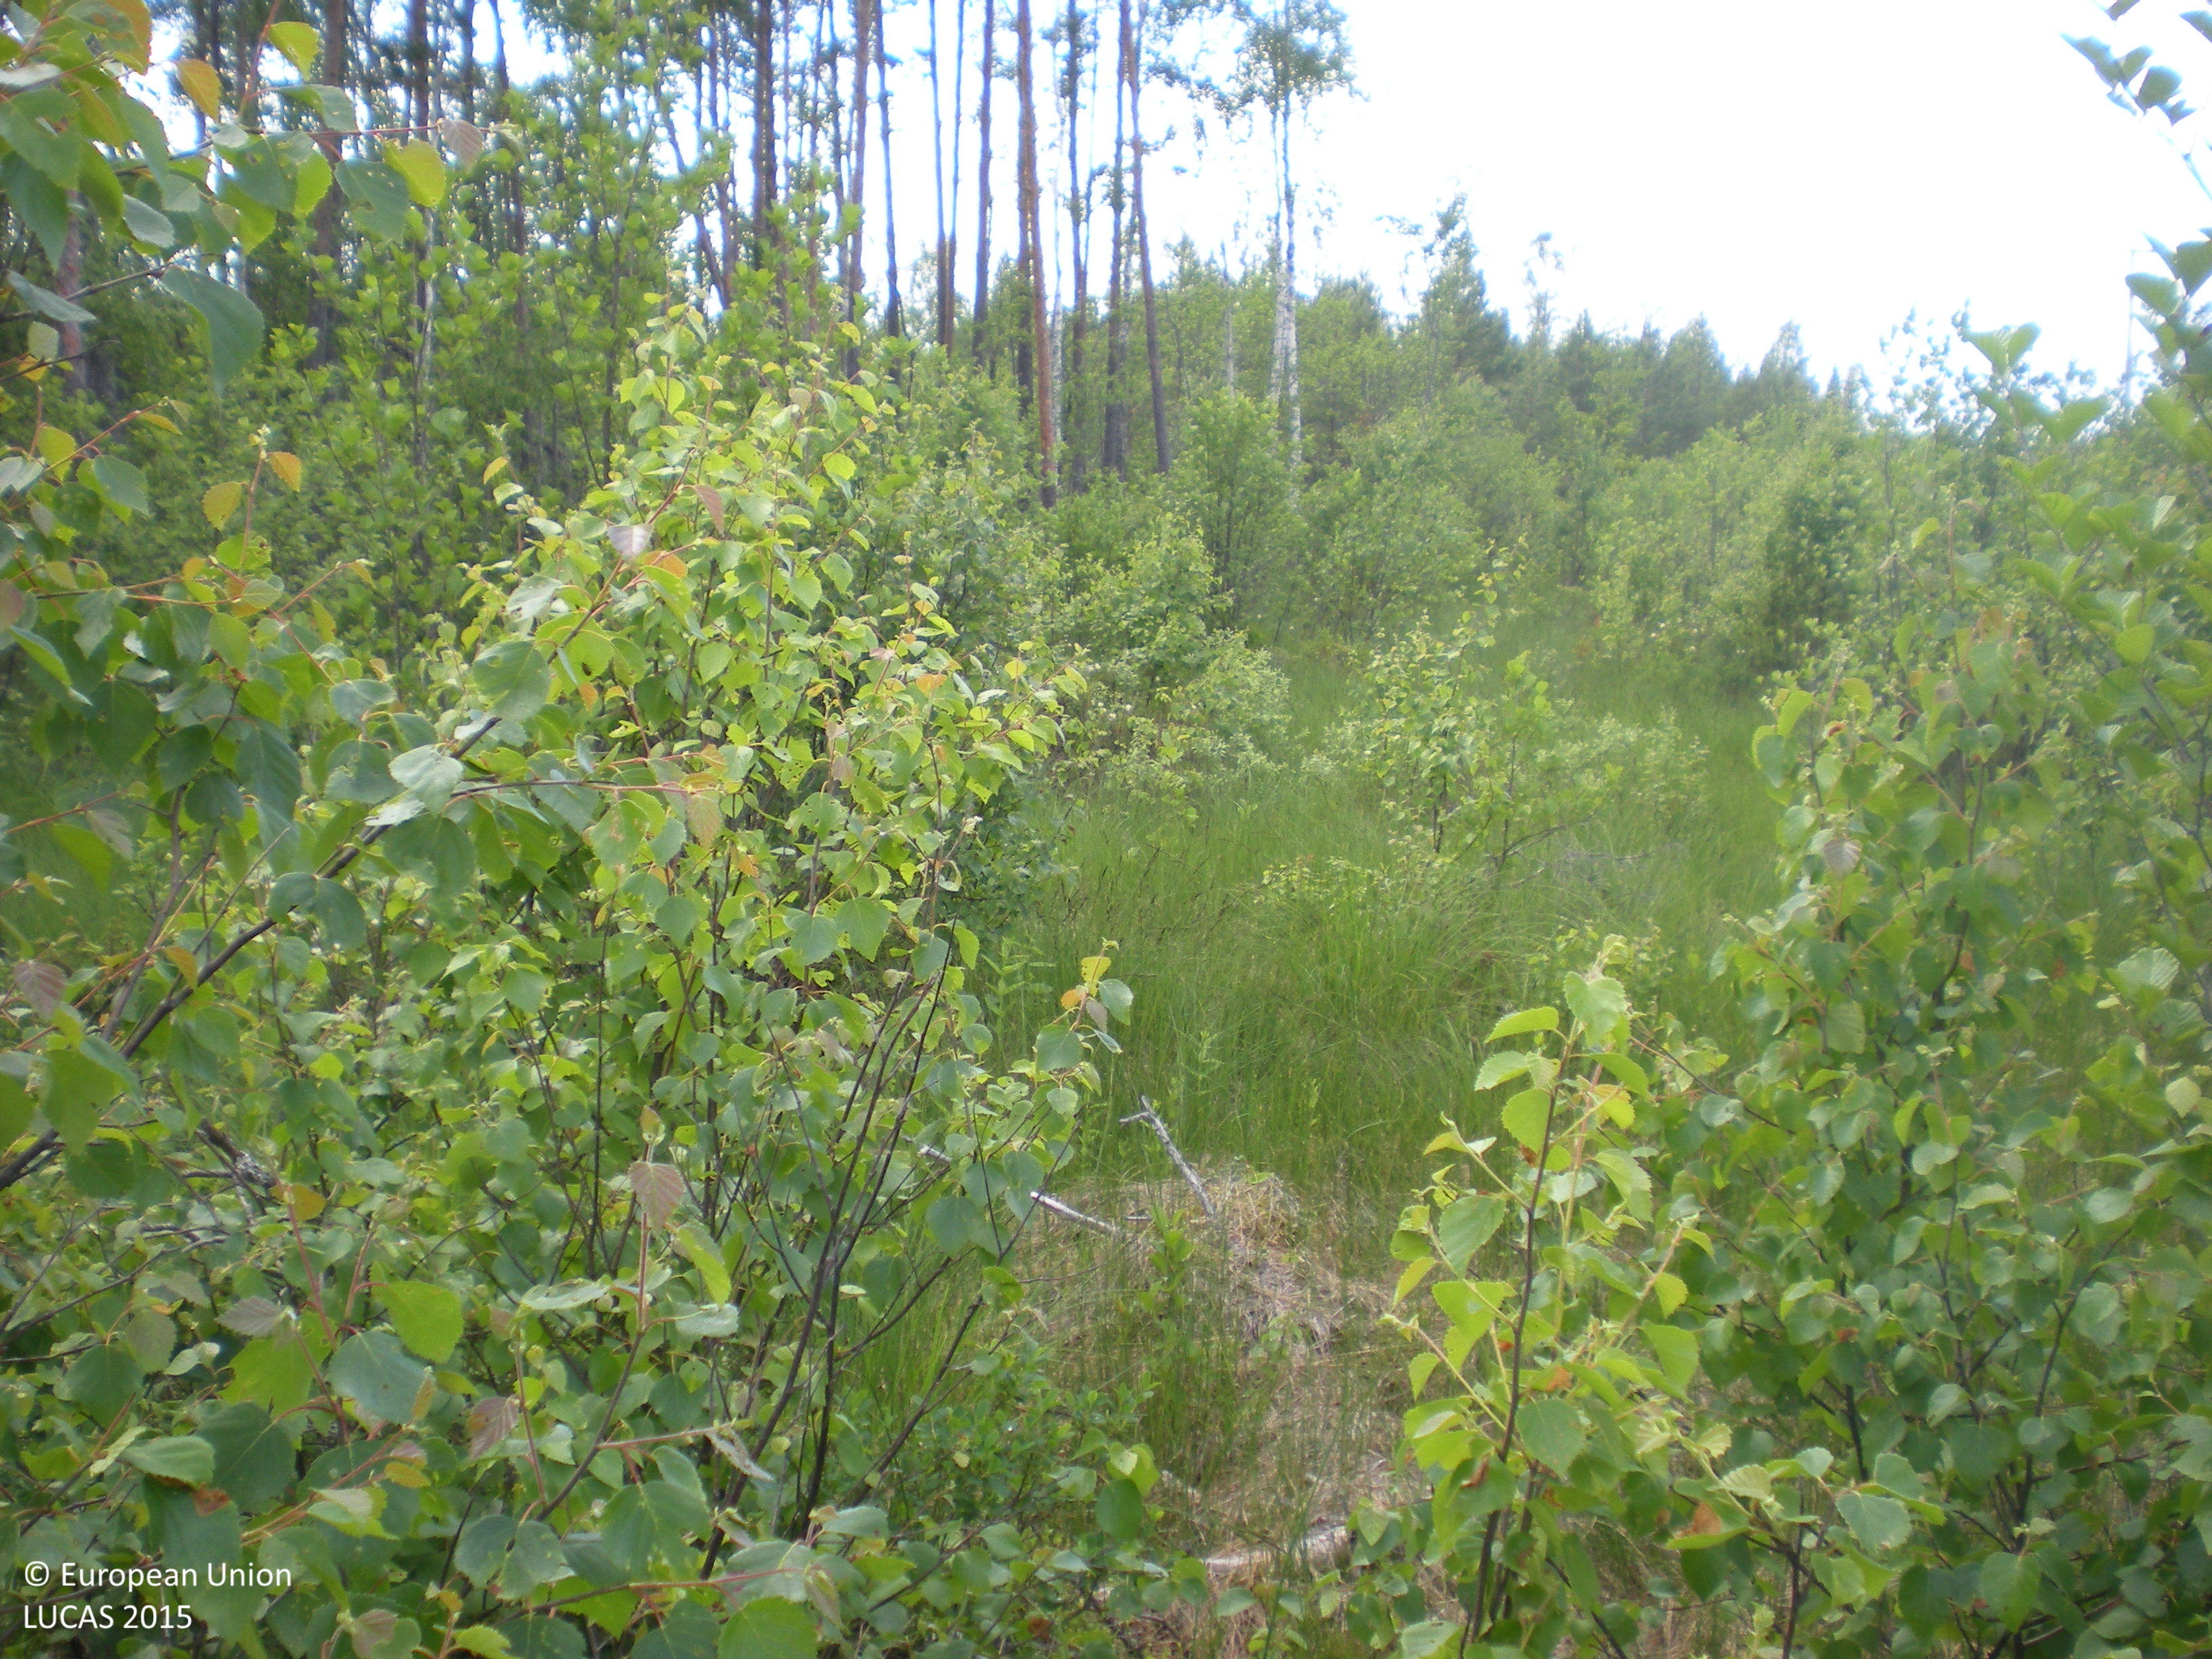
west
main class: Woodland
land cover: Broadleaved woodland
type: boreal forest
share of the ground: 25 - 50 %
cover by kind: herbaceous plants 50 %, broadleaved forest trees 30 %, coniferous forest trees 10 %, shrubs 10 %
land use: Forestry
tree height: < 5 m
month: June
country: SE
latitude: 60.4340
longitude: 17.8230
